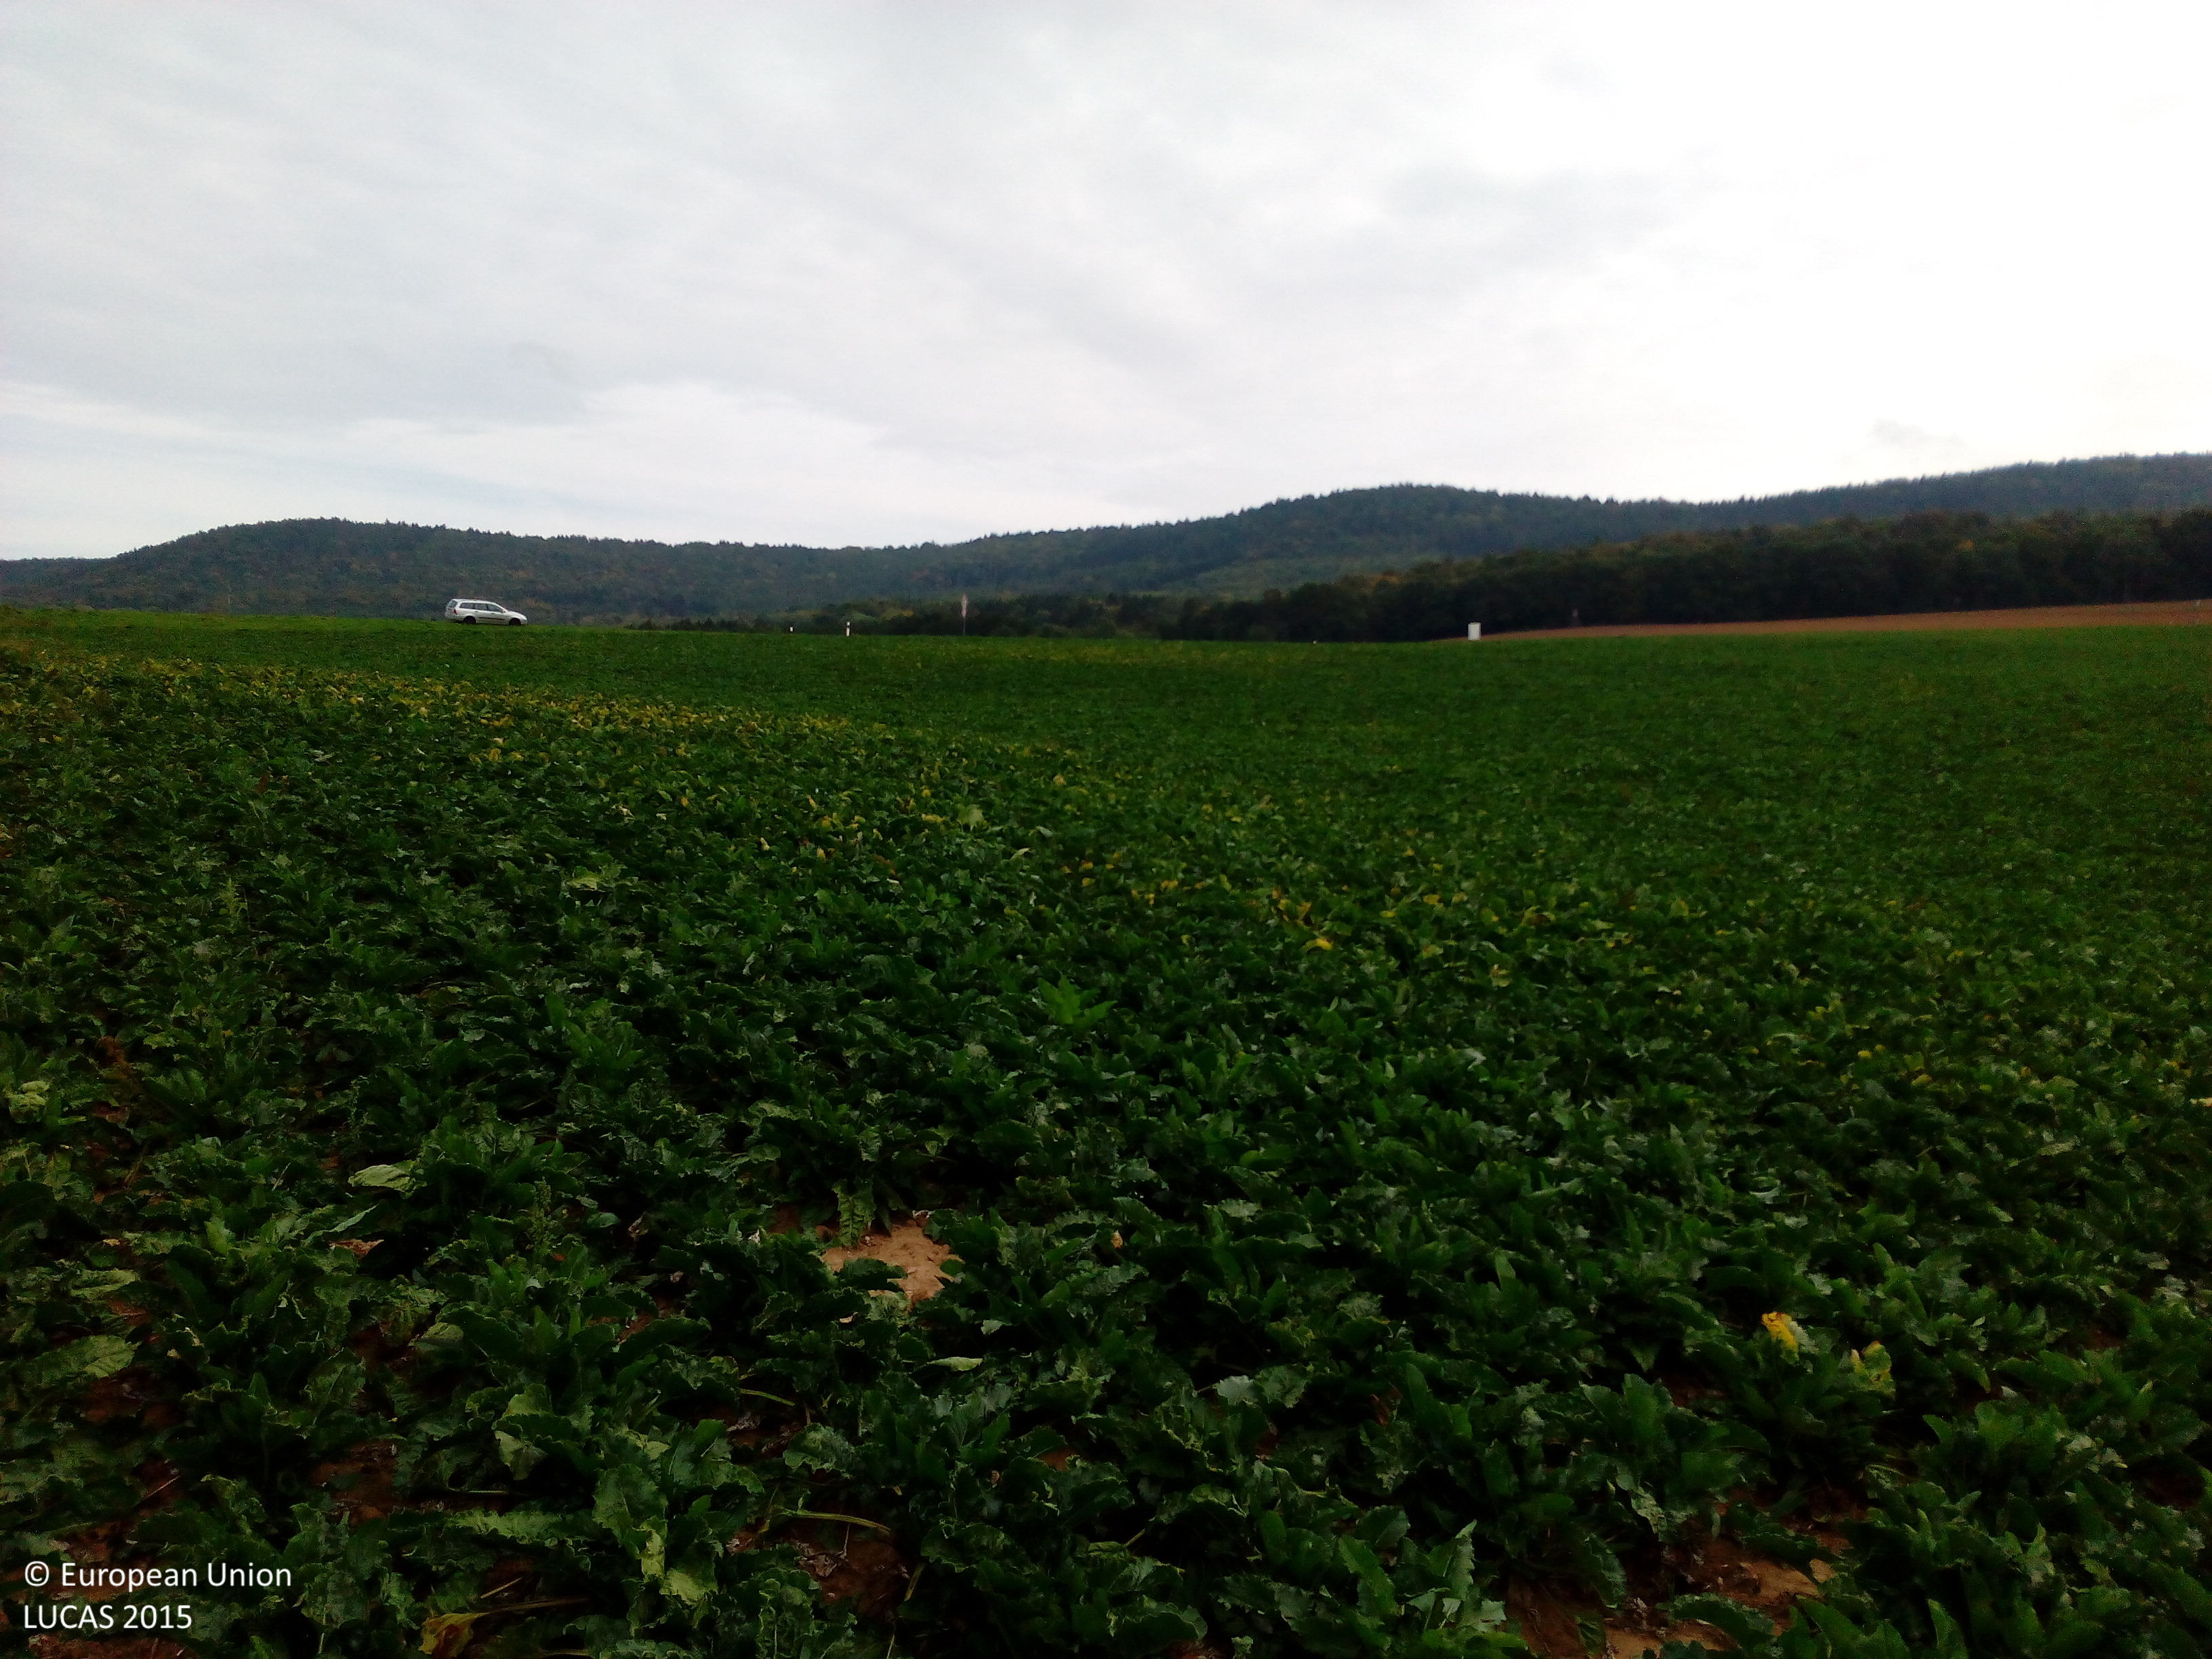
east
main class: Cropland
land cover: Sugar beet
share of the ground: > 75 %
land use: Agriculture (excluding fallow land and kitchen gardens)
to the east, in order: Sugar beet; Grassland without tree/shrub cover; Paved roads, cycling and walking lanes; Ditches and canals; Grass margins; Other bare soil
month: October
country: DE
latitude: 50.1635
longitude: 9.2023
